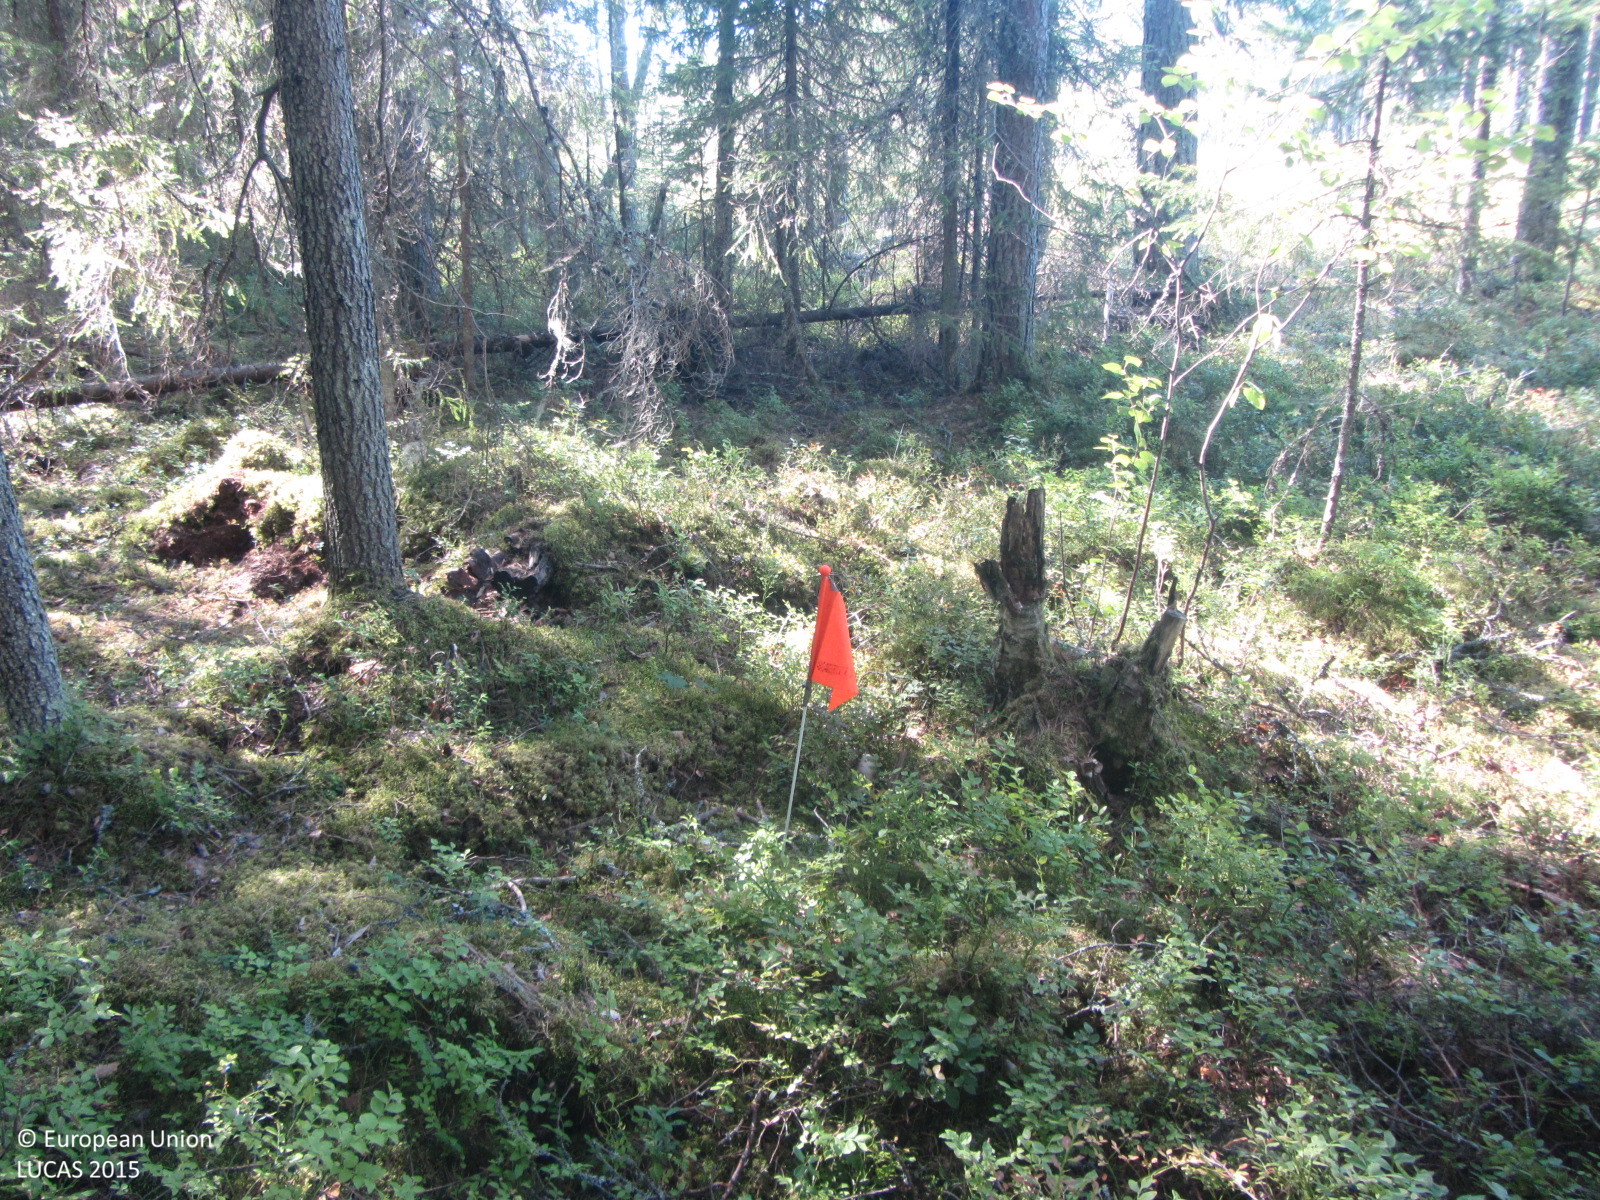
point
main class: Woodland
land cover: Other coniferous woodland
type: boreal forest
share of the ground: > 75 %
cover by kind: coniferous forest trees 80 %, shrubs 10 %, broadleaved forest trees 5 %, lichens and mosses 5 %
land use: Forestry
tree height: > 5 m
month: August
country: FI
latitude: 61.3445
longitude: 25.1245
